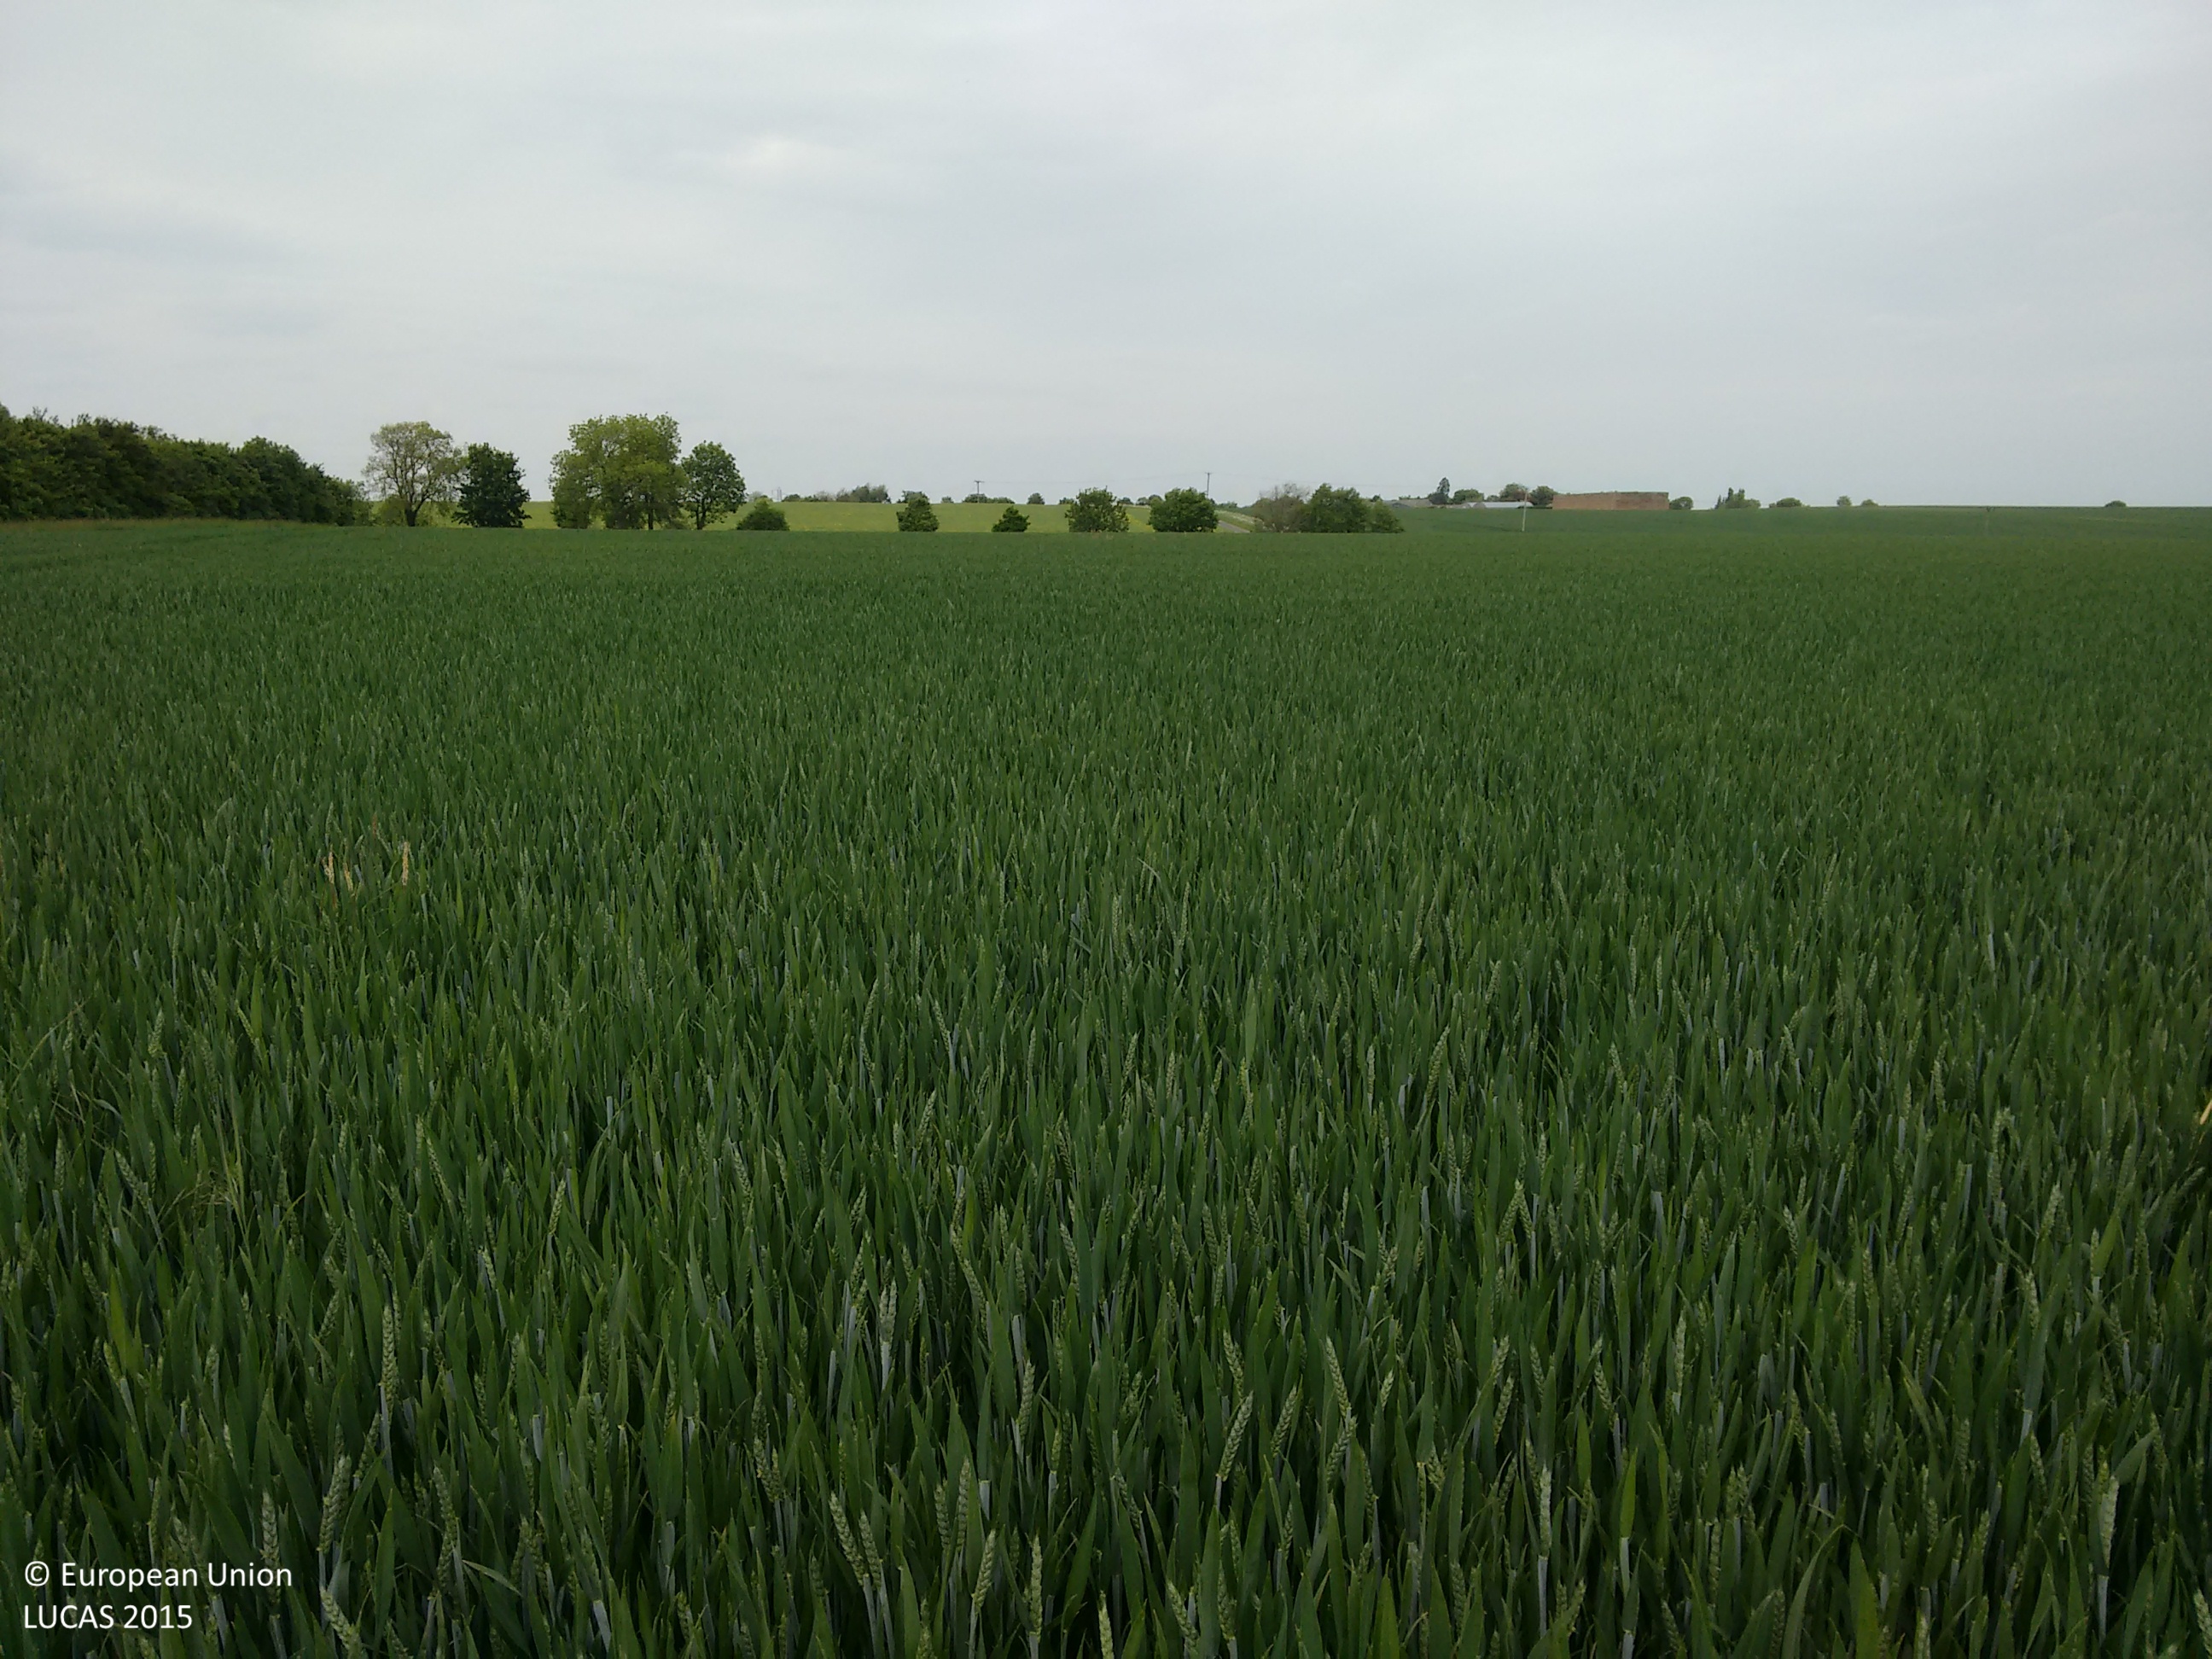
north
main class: Cropland
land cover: Common wheat
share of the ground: > 75 %
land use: Agriculture (excluding fallow land and kitchen gardens)
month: May
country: GB
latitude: 52.8835
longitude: -0.3644
